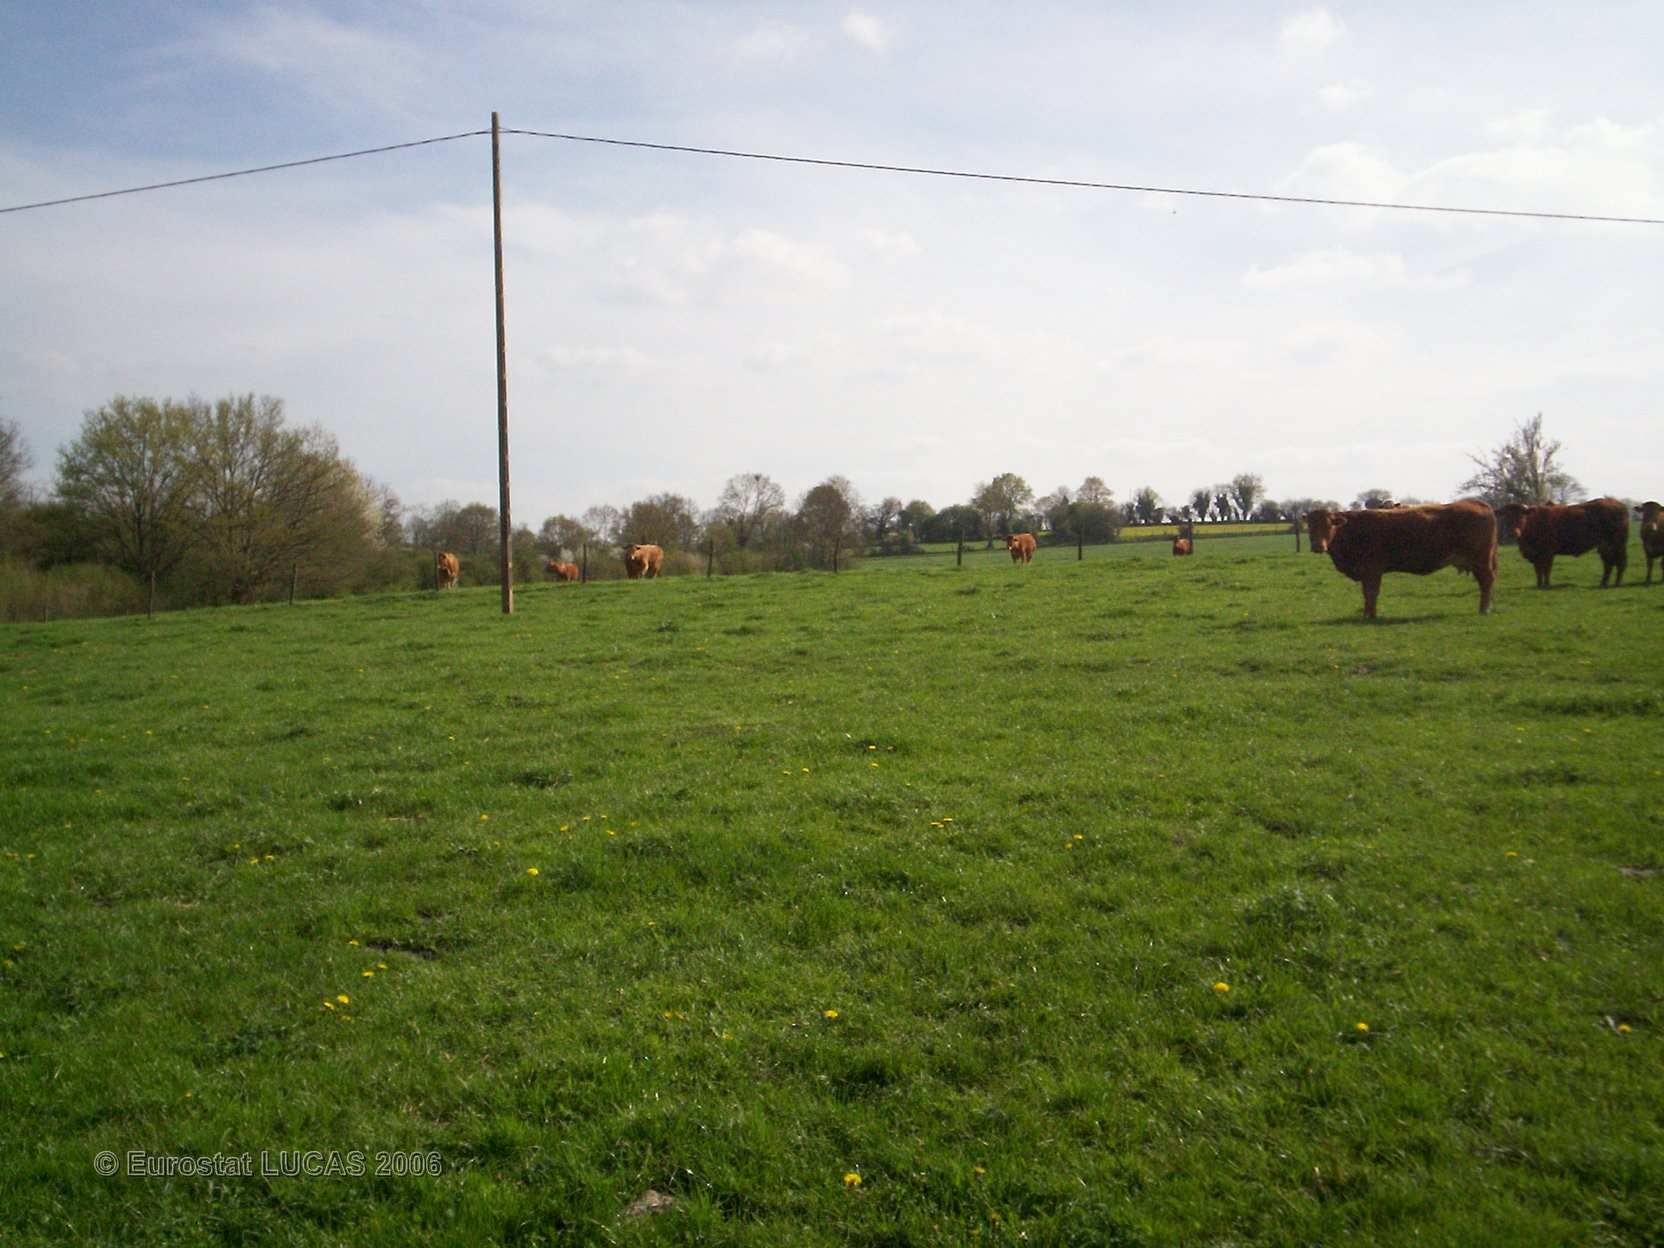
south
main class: Grassland
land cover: Grassland without tree/shrub cover
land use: Agriculture (excluding fallow land and kitchen gardens)
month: April
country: FR
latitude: 48.1452
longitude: -0.2320
